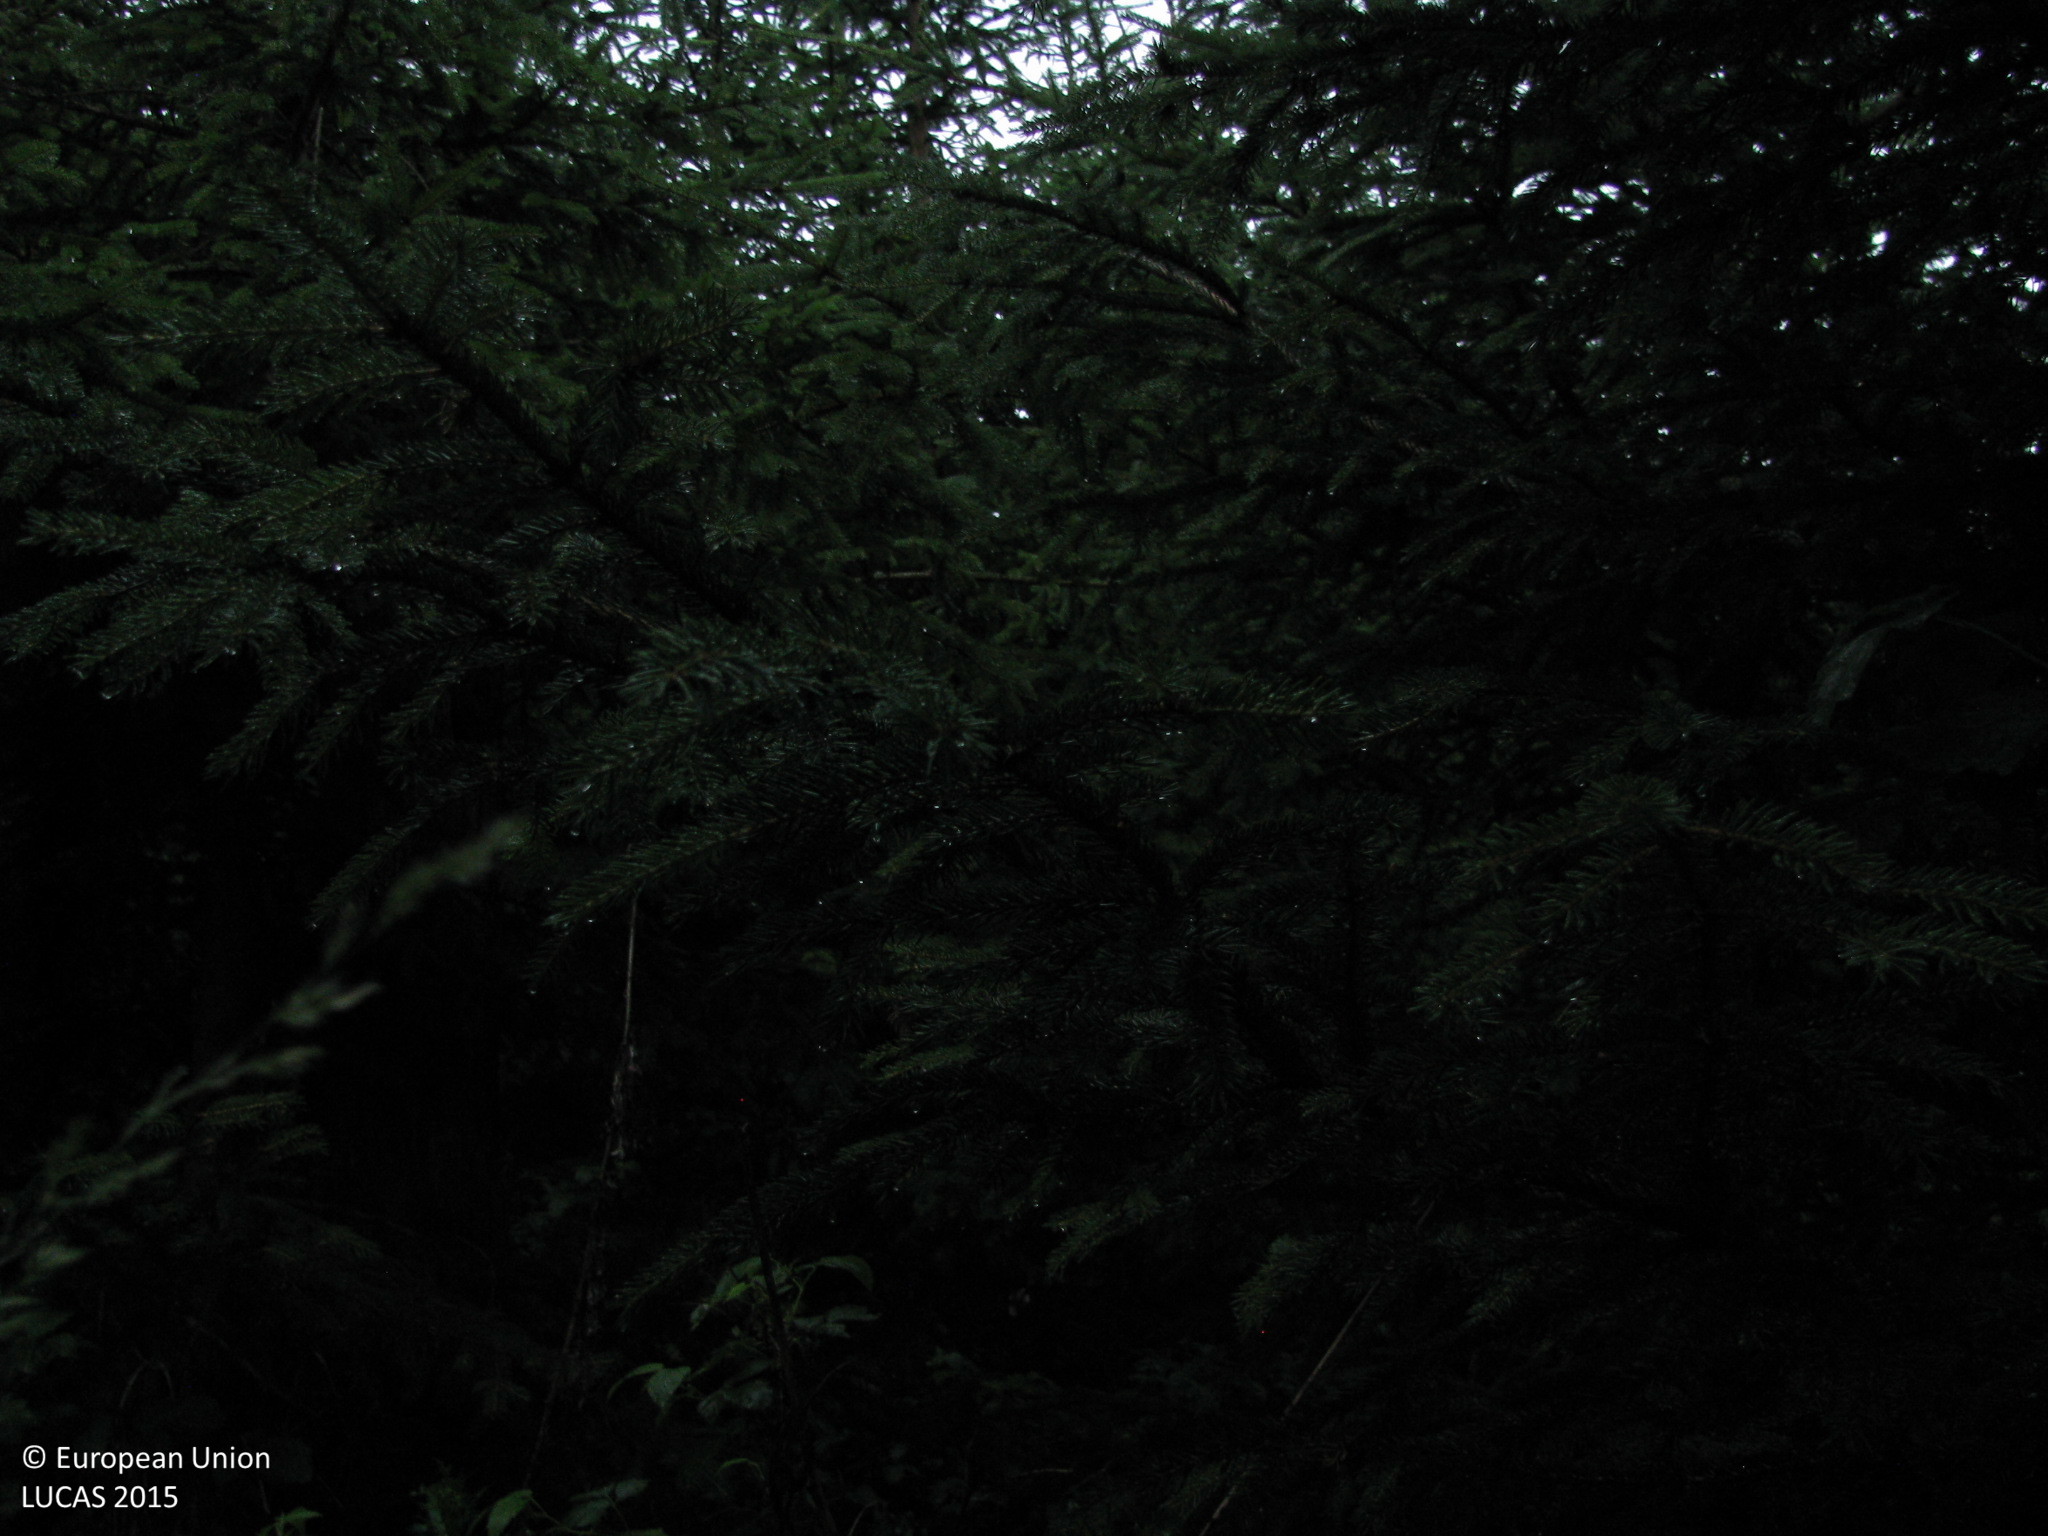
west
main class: Woodland
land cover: Spruce dominated coniferous woodland
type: alpine coniferous forest
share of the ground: 50 - 75 %
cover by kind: coniferous forest trees 75 %, herbaceous plants 25 %
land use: Forestry
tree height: > 5 m
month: July
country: AT
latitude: 47.1472
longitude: 14.7595
